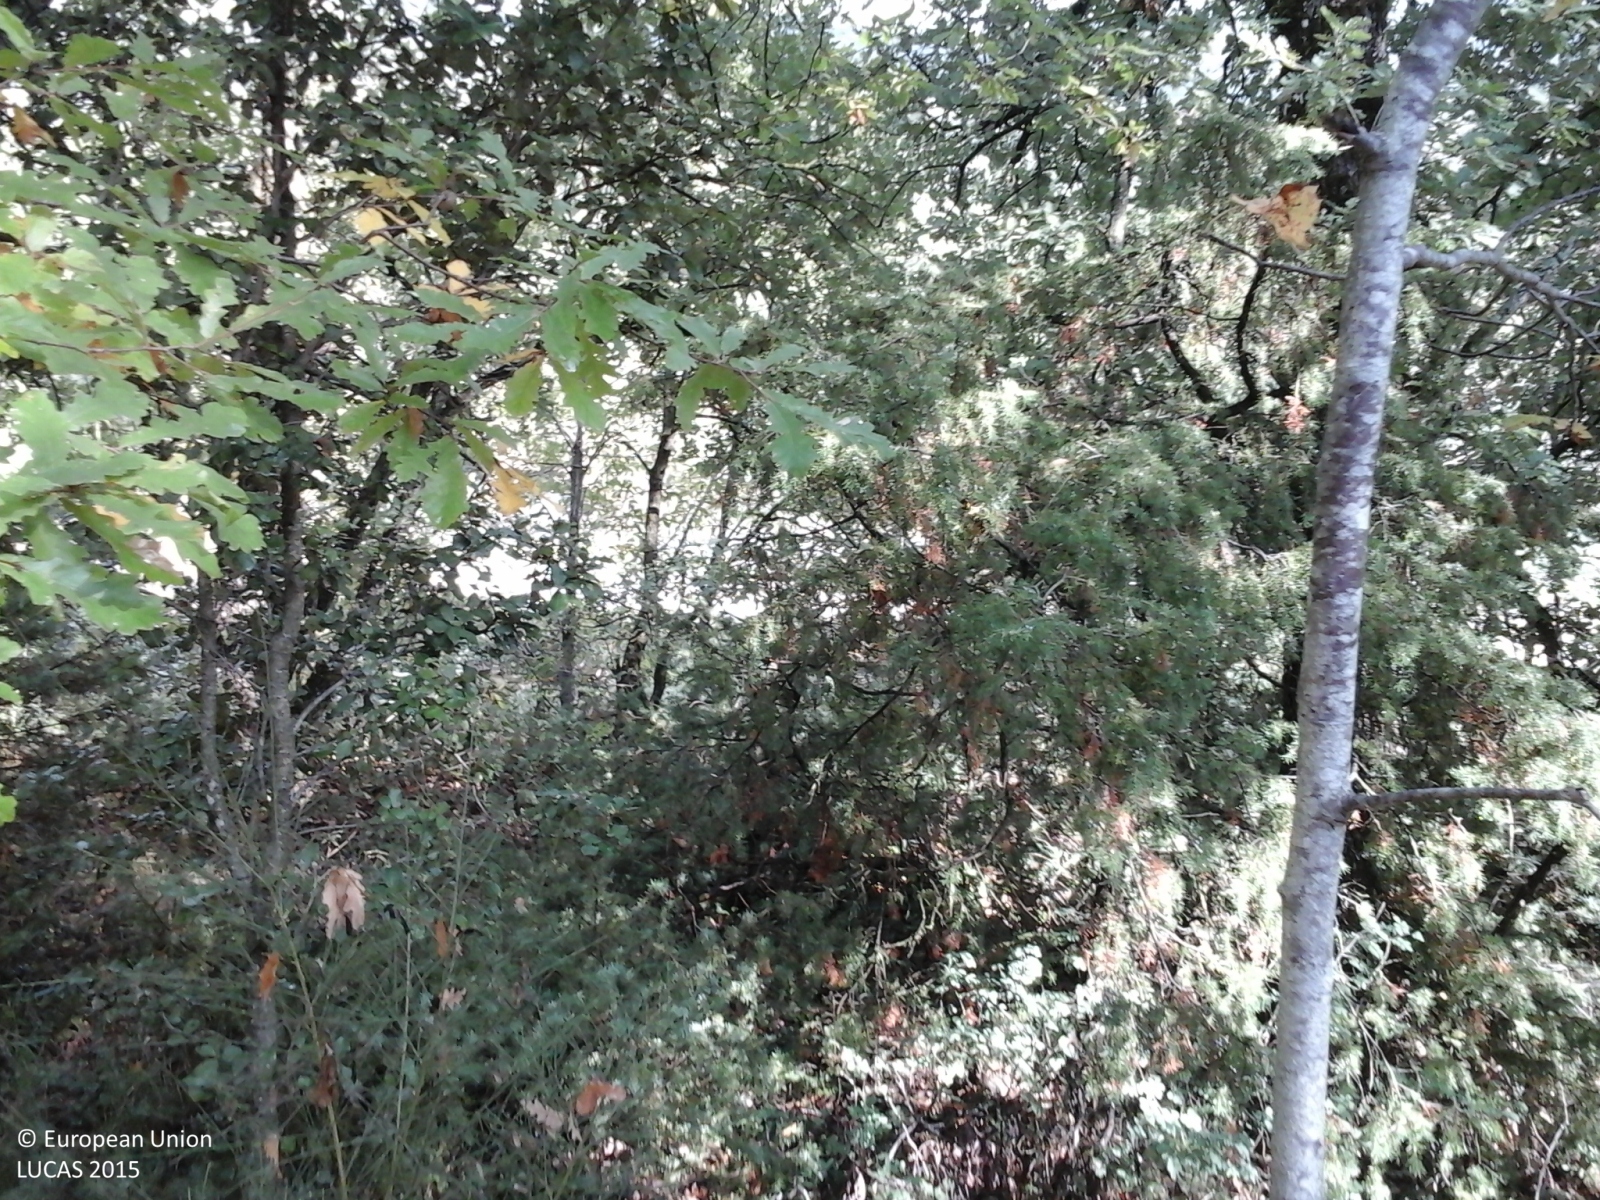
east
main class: Woodland
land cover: Broadleaved woodland
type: thermophilous deciduous forest
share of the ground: > 75 %
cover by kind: broadleaved forest trees 100 %
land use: Forestry
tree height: > 5 m
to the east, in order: Broadleaved woodland; Fences; Broadleaved woodland; Tracks; Grassland without tree/shrub cover; Paved roads, cycling and walking lanes; Fences; Olive groves; Electric lines; Olive groves; Broadleaved woodland; Other bare soil; Broadleaved woodland; Grassland without tree/shrub cover; Broadleaved woodland
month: October
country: IT
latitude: 42.7666
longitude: 12.5462
